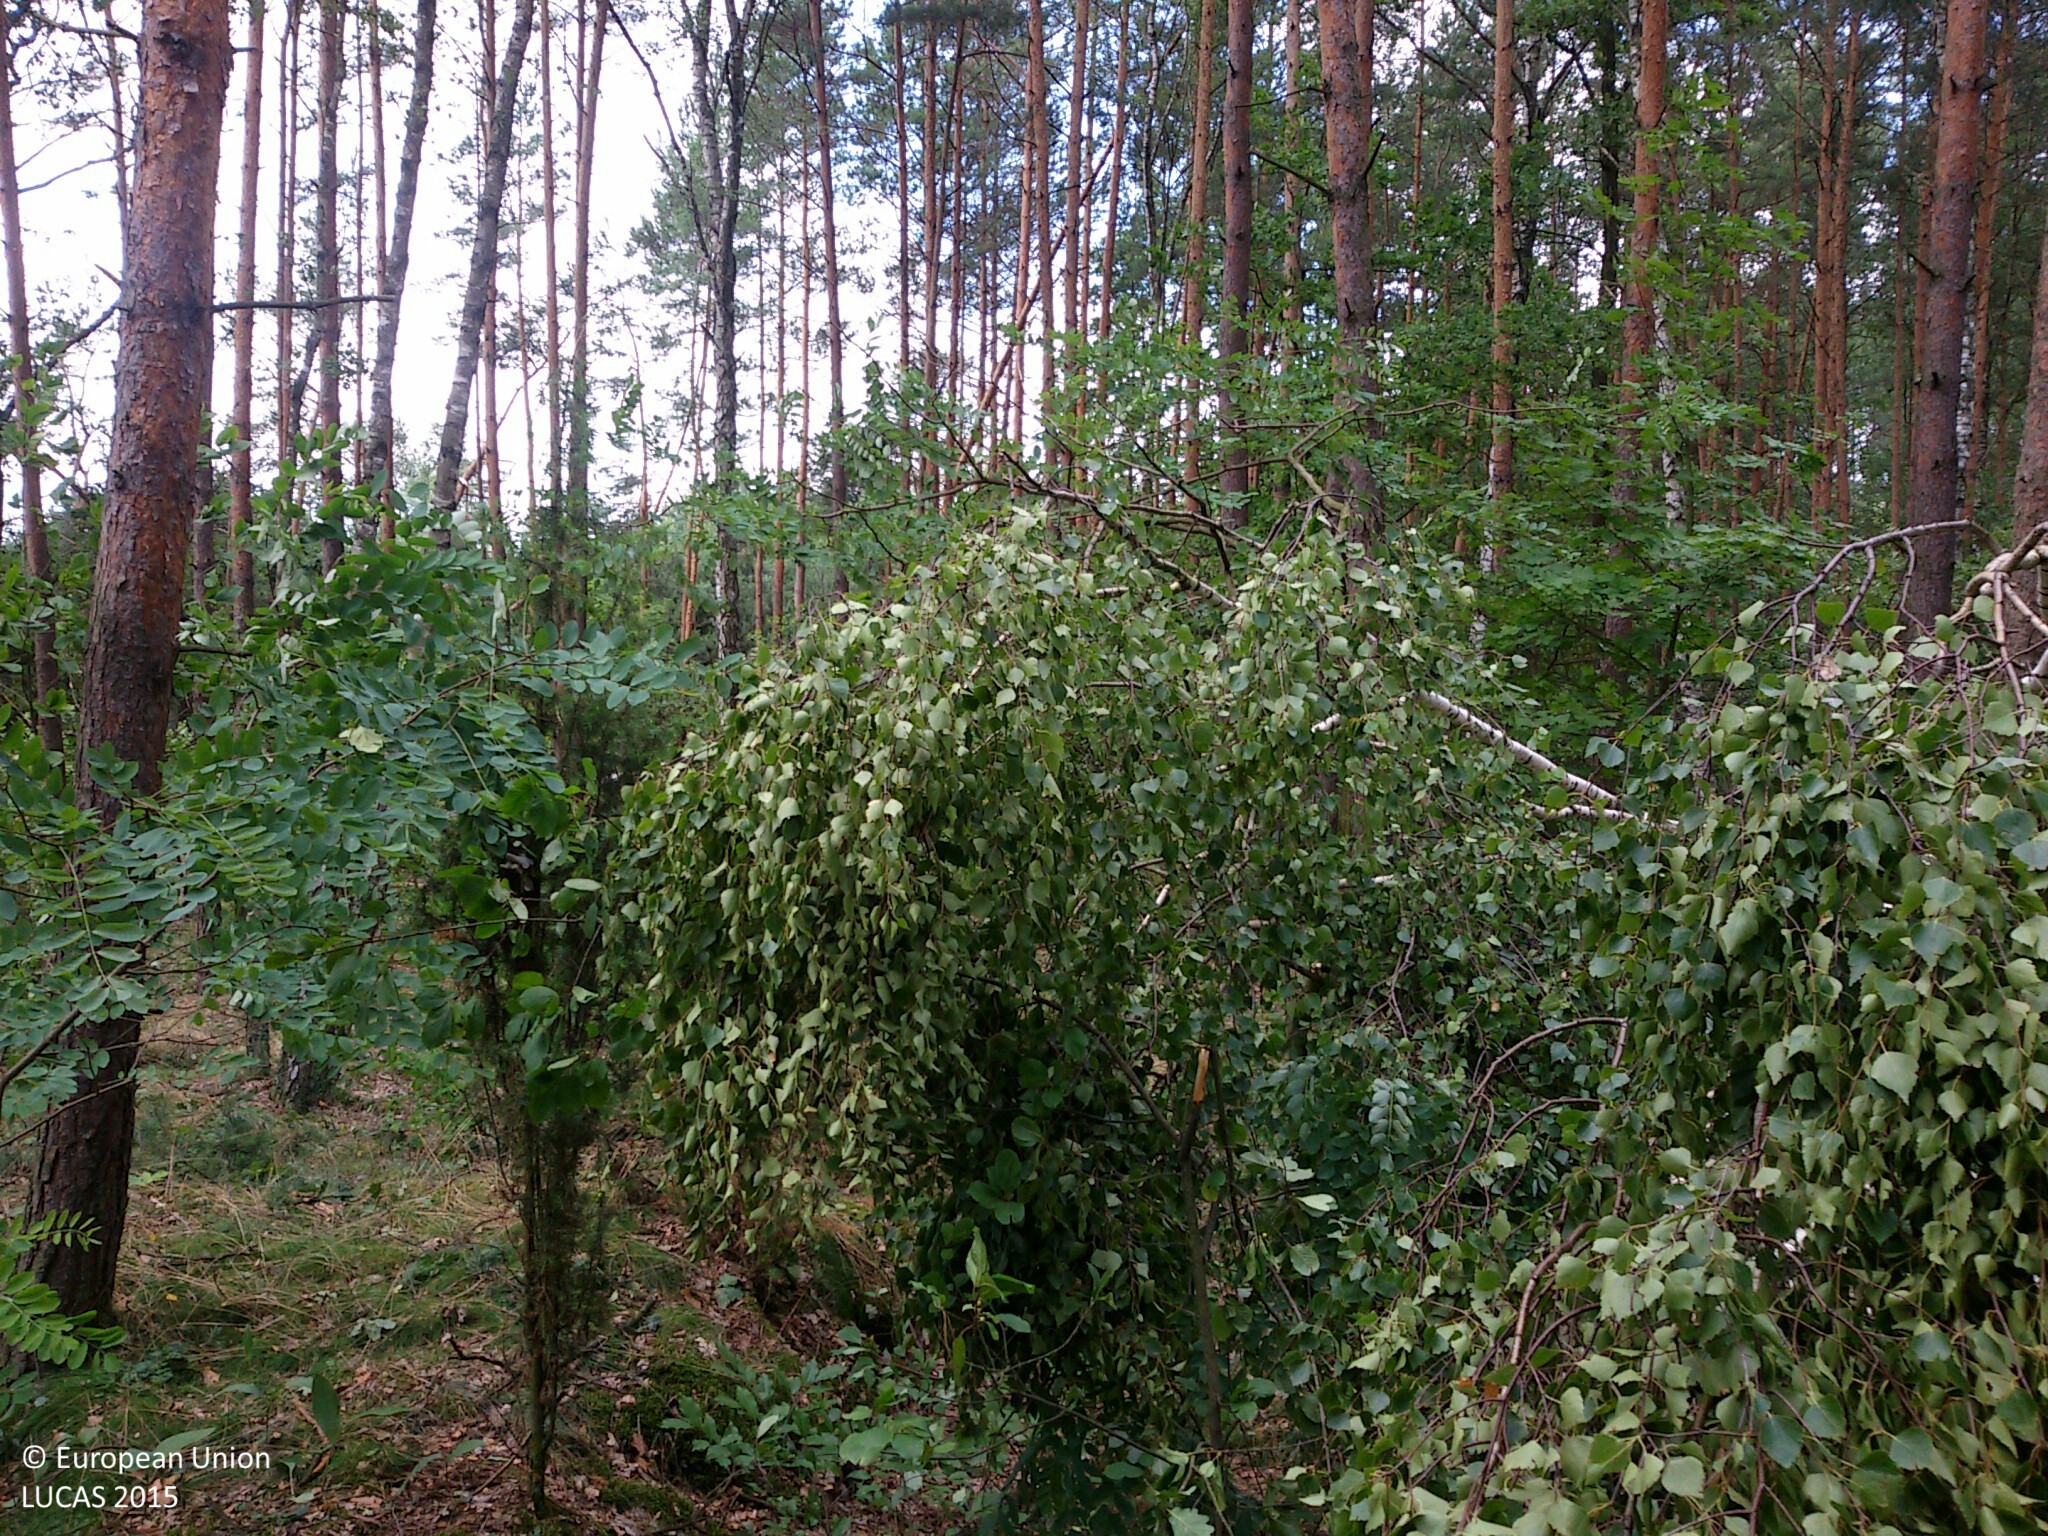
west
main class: Woodland
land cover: Pine dominated mixed woodland
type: hemiboreal forest and nemoral coniferous forest and mixed broadleaved-coniferous forest
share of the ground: 50 - 75 %
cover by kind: coniferous forest trees 45 %, broadleaved forest trees 25 %, shrubs 10 %, herbaceous plants 10 %, lichens and mosses 5 %, unconsolidated bare surface 5 %
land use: Forestry
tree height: > 5 m
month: July
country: PL
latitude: 52.9929
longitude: 21.3563
